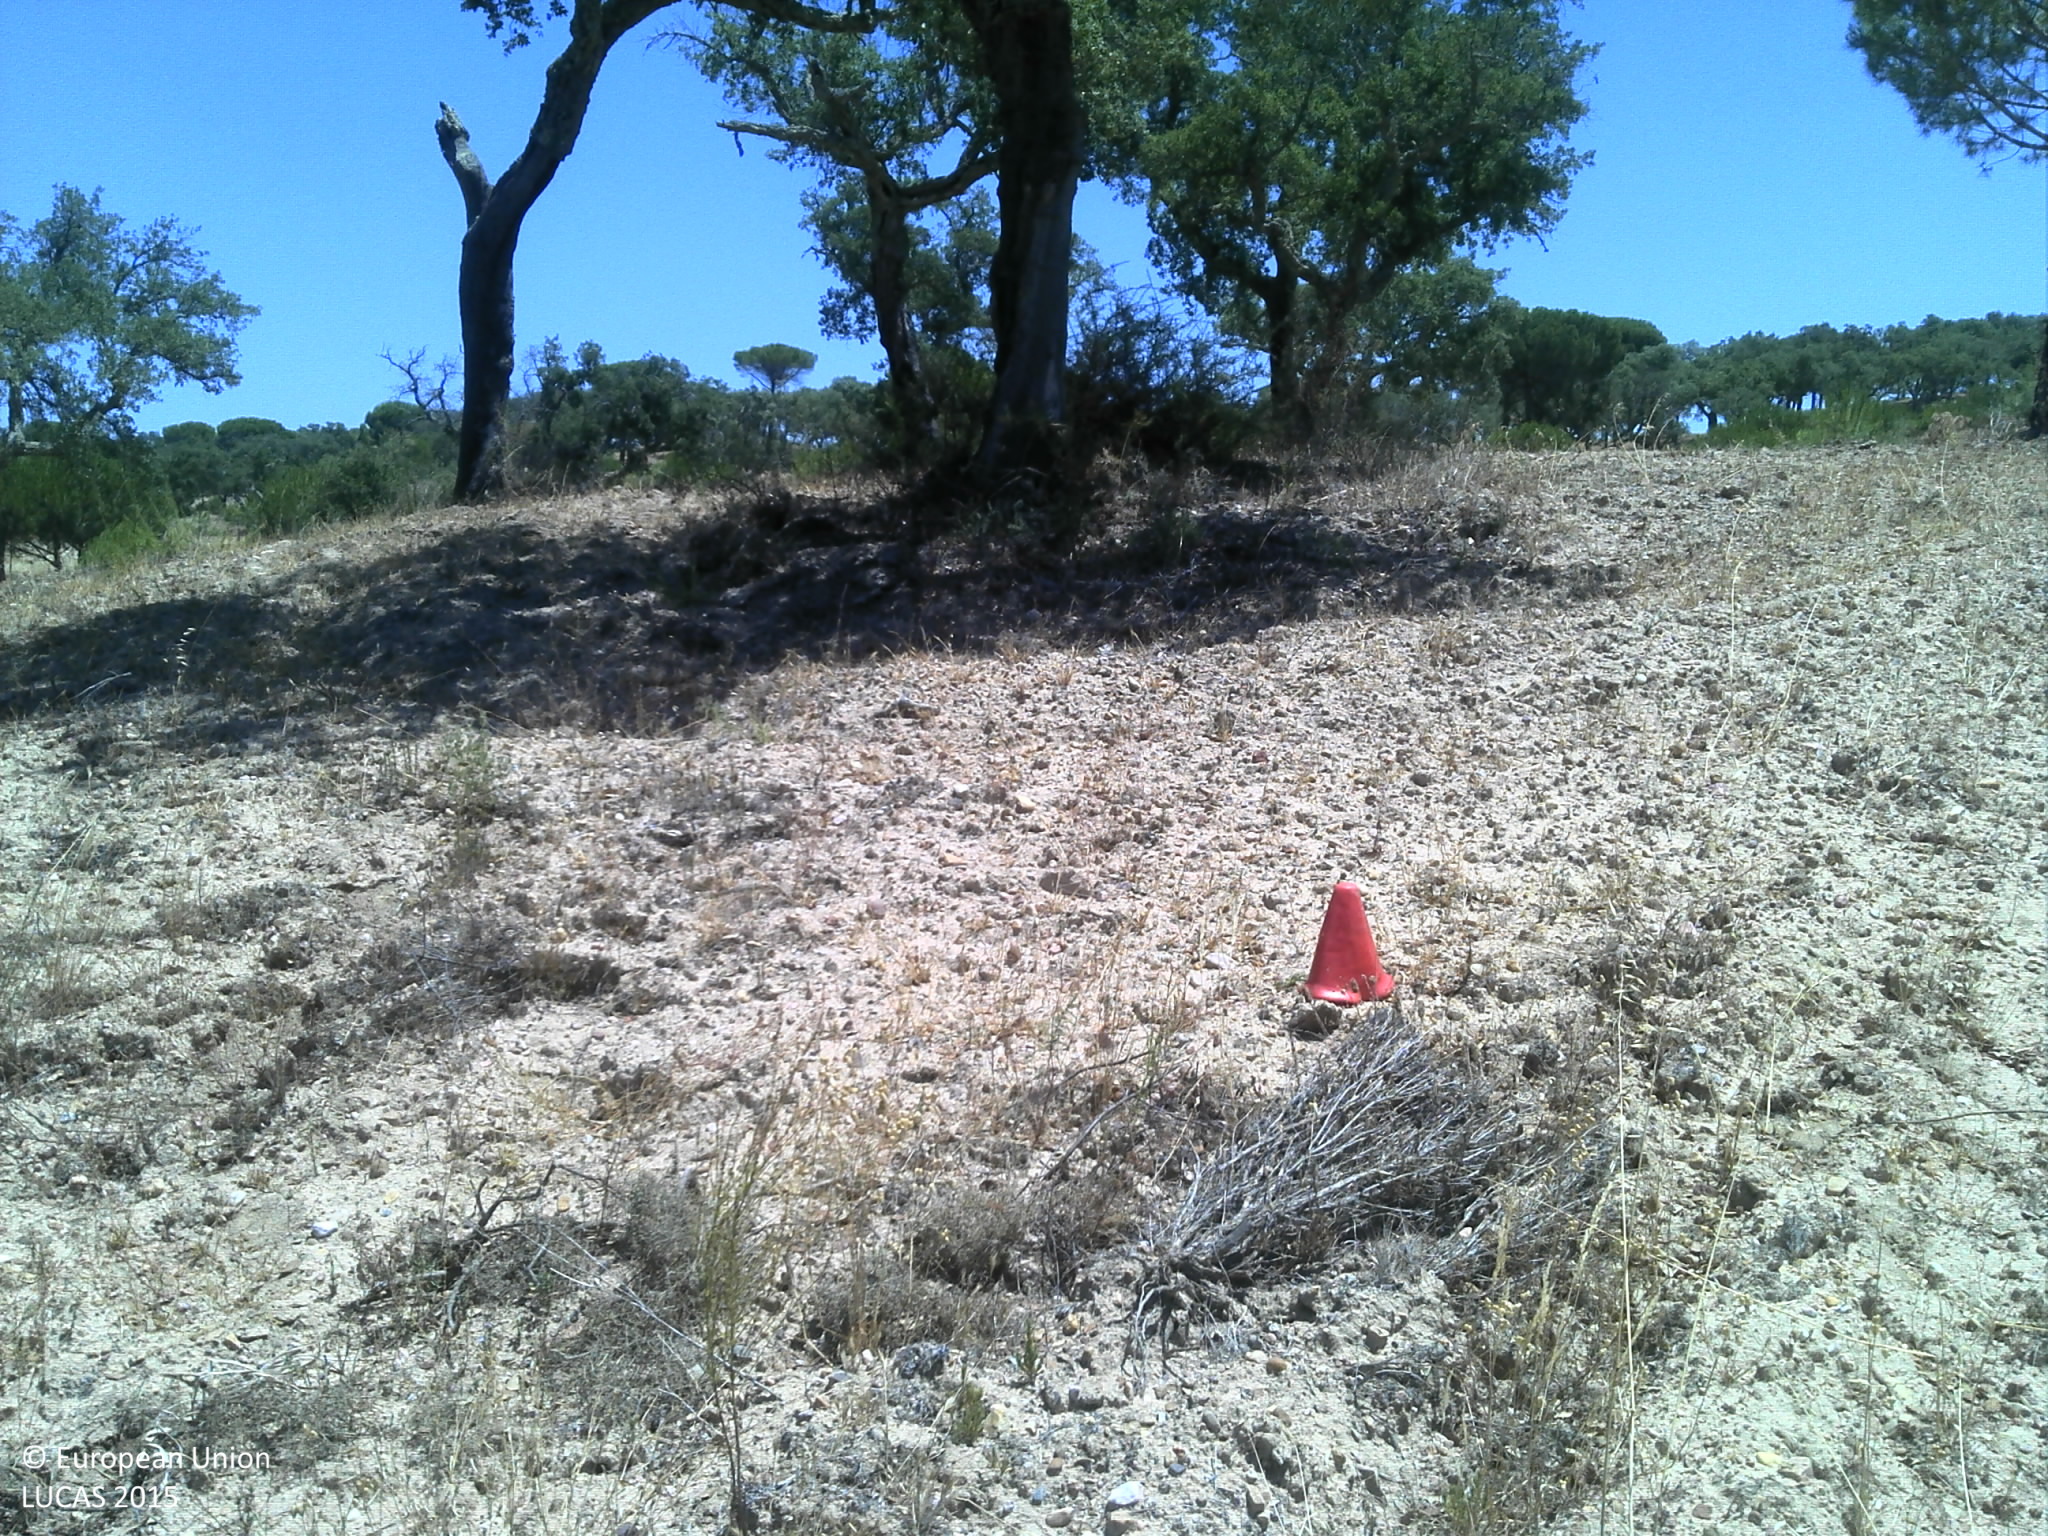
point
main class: Woodland
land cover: Broadleaved woodland
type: broadleaved evergreen forest
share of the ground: 25 - 50 %
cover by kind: unconsolidated bare surface 55 %, broadleaved forest trees 35 %, herbaceous plants 10 %
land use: Forestry
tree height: > 5 m
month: July
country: PT
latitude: 39.0511
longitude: -8.2803
